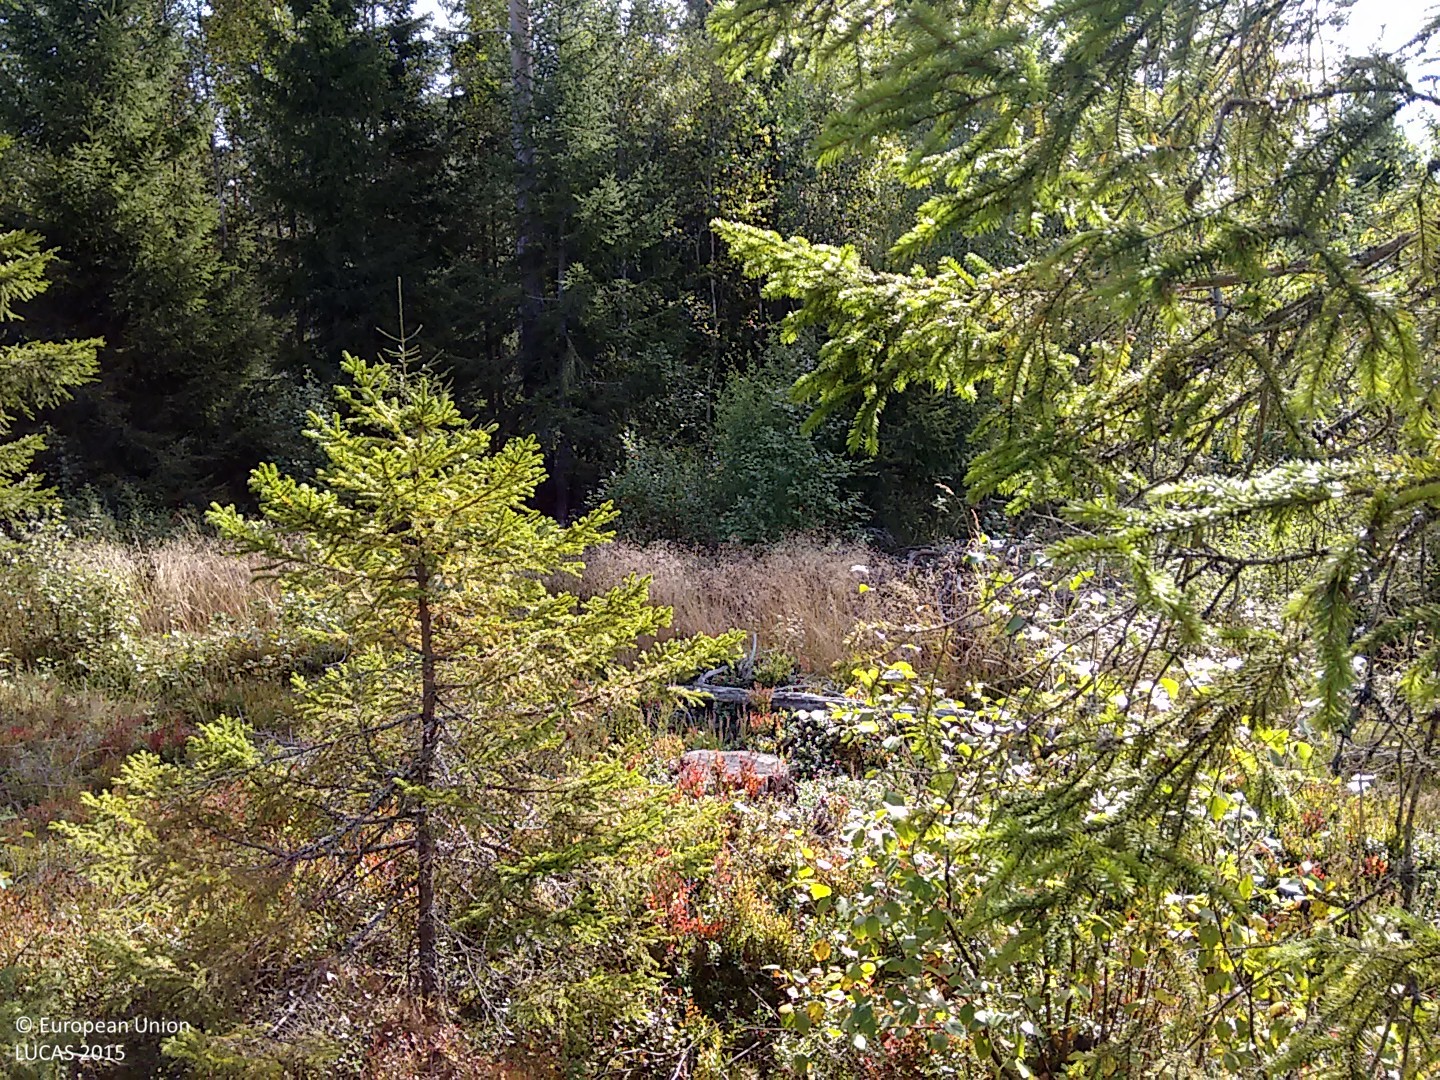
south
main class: Woodland
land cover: Other coniferous woodland
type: hemiboreal forest and nemoral coniferous forest and mixed broadleaved-coniferous forest
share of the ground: > 75 %
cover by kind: coniferous forest trees 70 %, broadleaved forest trees 15 %, herbaceous plants 15 %
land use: Forestry
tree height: > 5 m
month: September
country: FI
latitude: 60.7369
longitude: 21.6290
